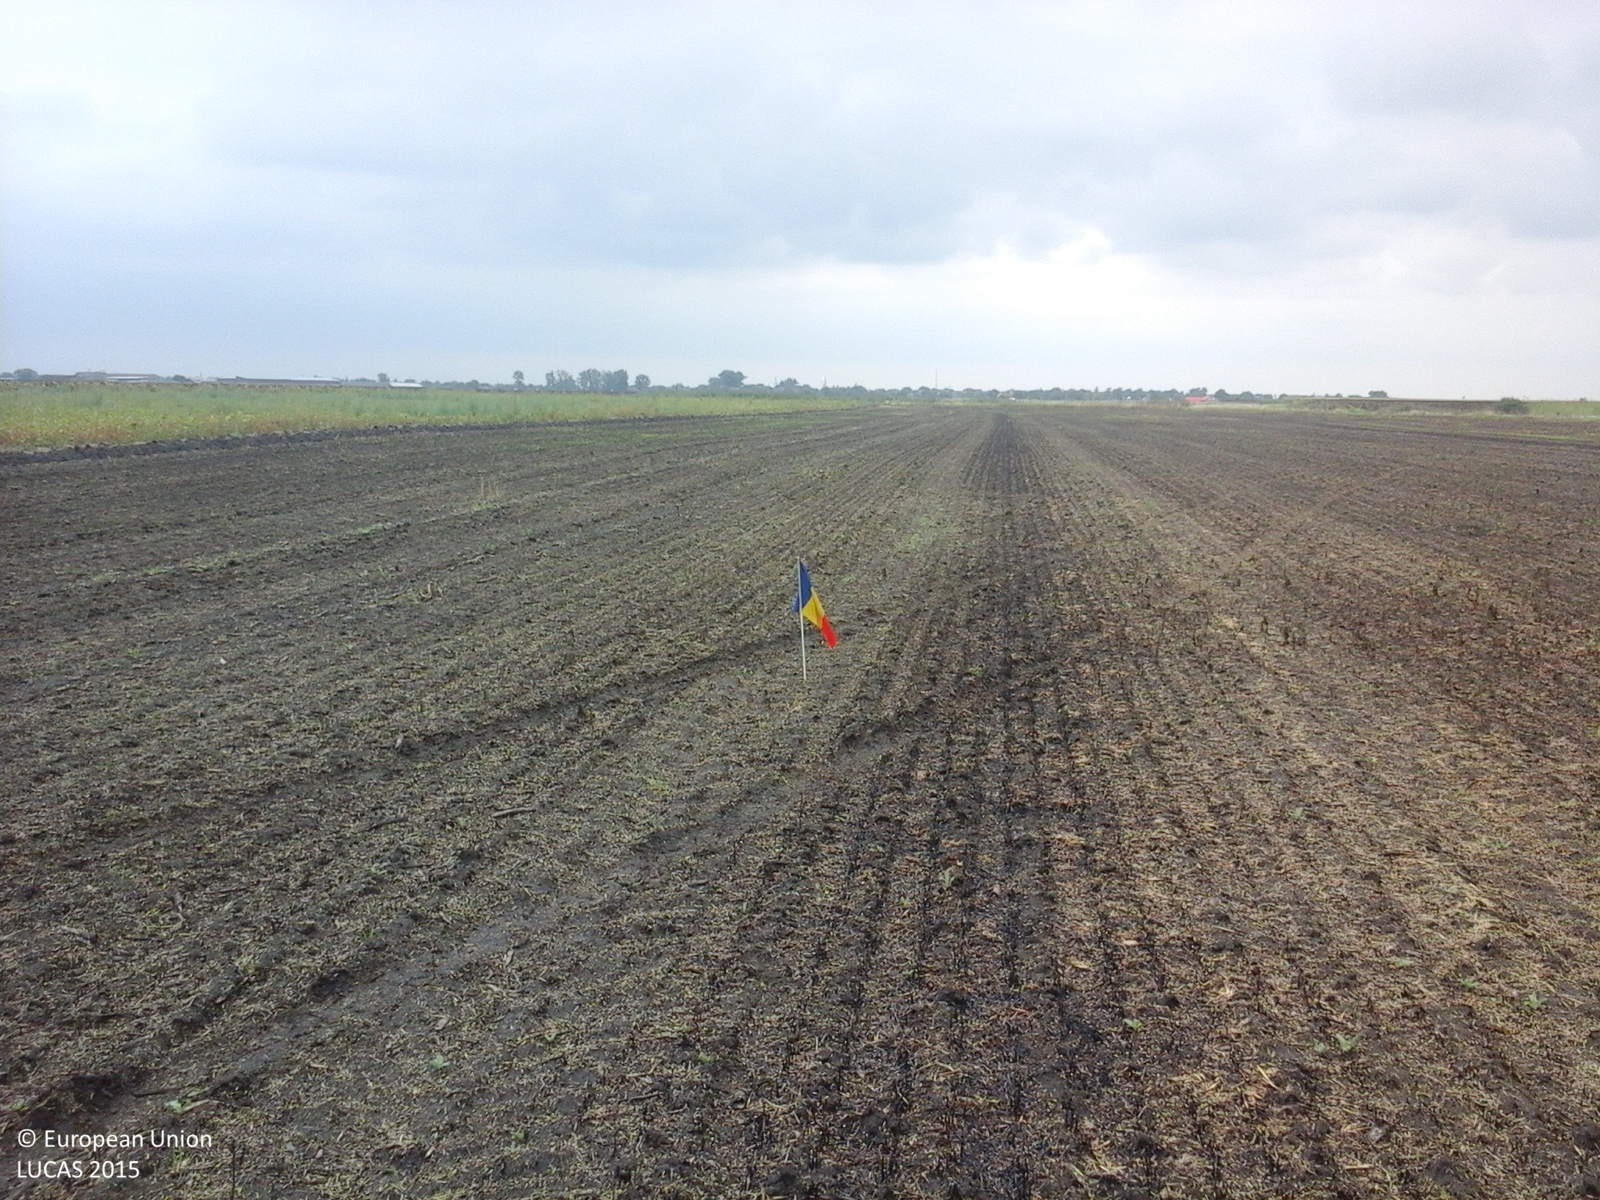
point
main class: Cropland
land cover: Common wheat
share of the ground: < 10 %
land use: Agriculture (excluding fallow land and kitchen gardens)
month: August
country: RO
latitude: 46.1417
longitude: 20.3147
